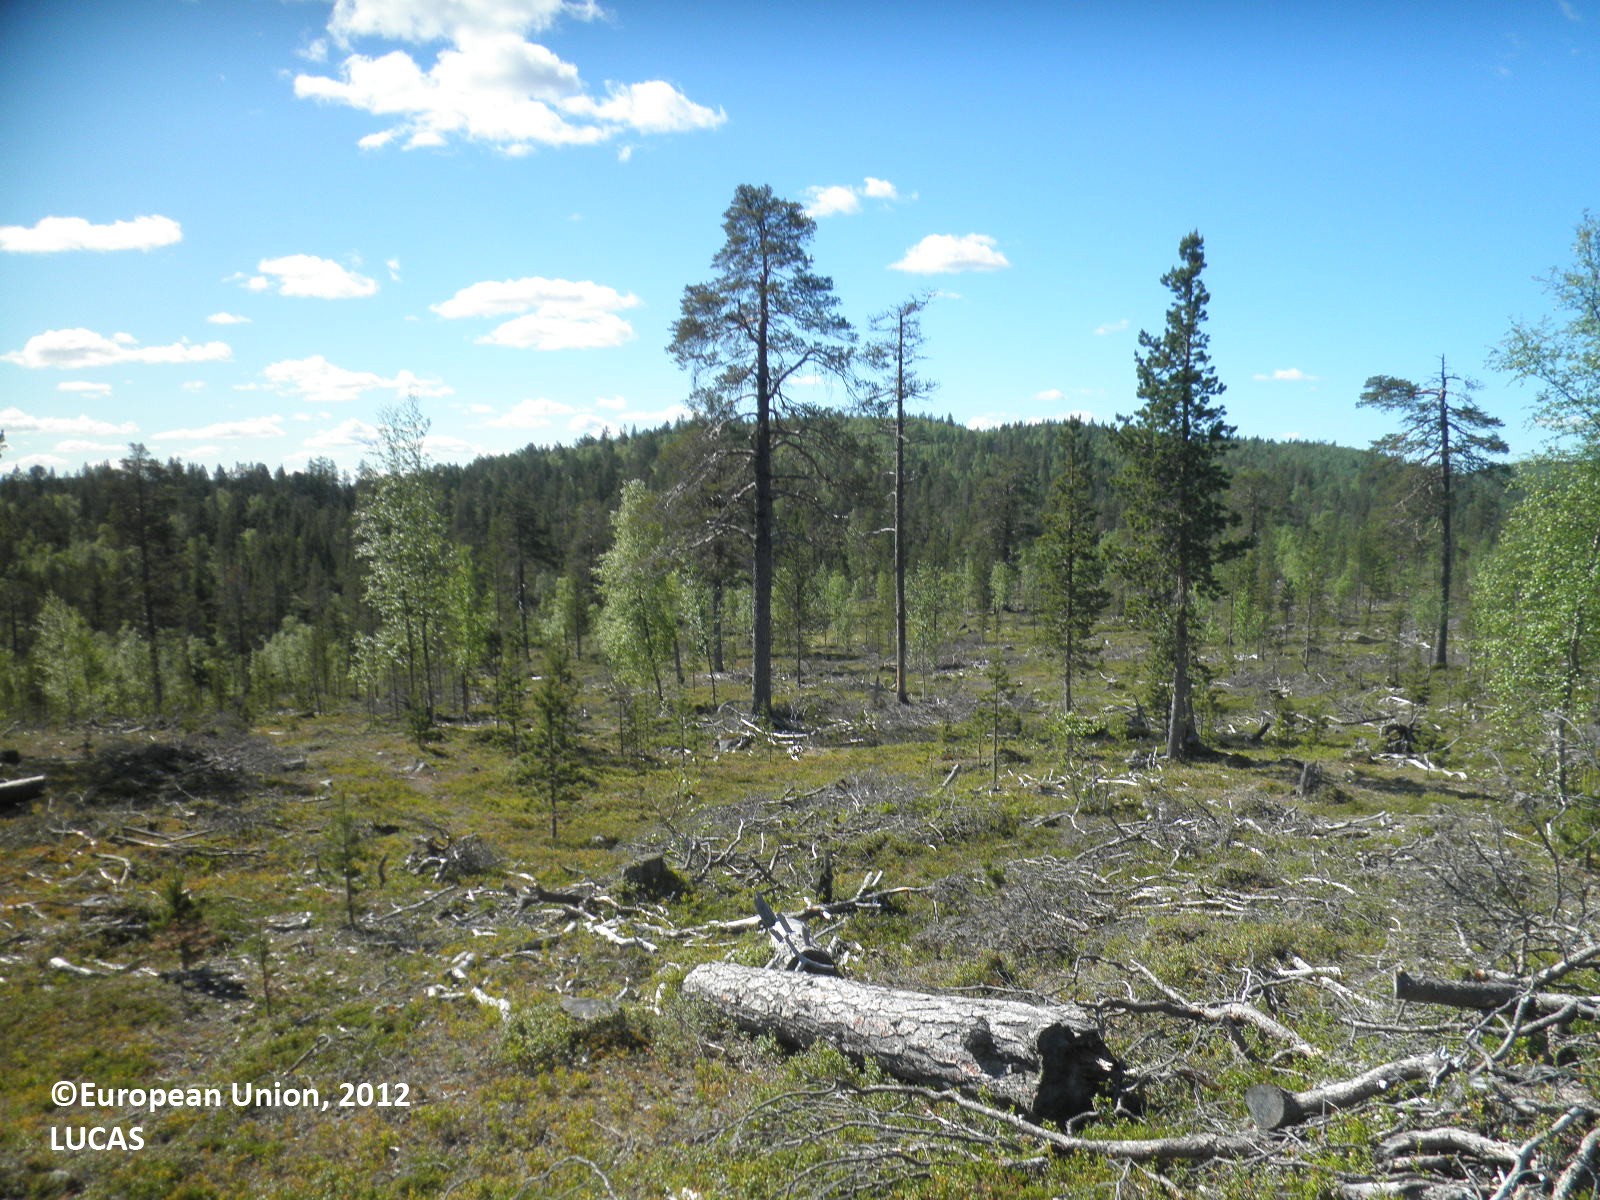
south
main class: Shrubland
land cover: Shrubland with sparse tree cover
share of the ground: 50 - 75 %
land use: Forestry
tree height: < 5 m
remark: Clear cut
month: July
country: FI
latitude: 68.7971
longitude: 26.6271
